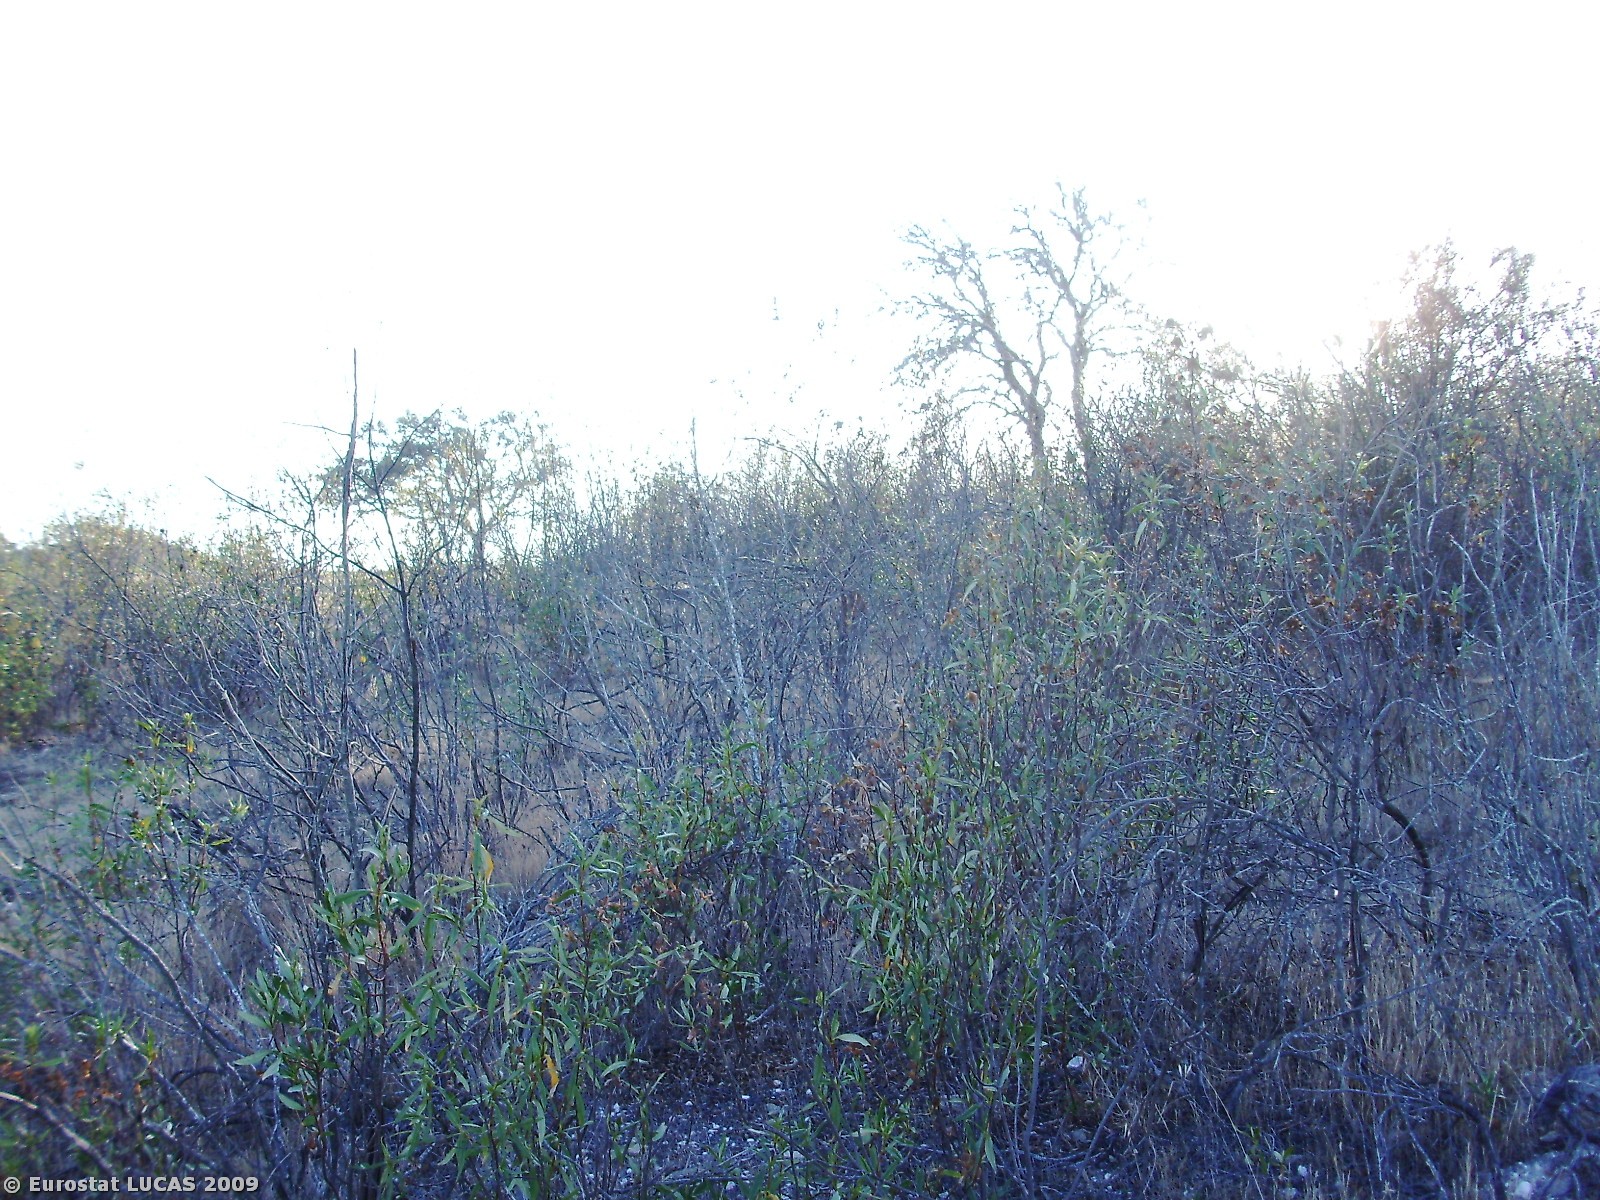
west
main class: Grassland
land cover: Spontaneously vegetated surfaces
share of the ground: 50 - 75 %
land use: Fallow land
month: June
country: PT
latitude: 38.1046
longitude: -8.4854
